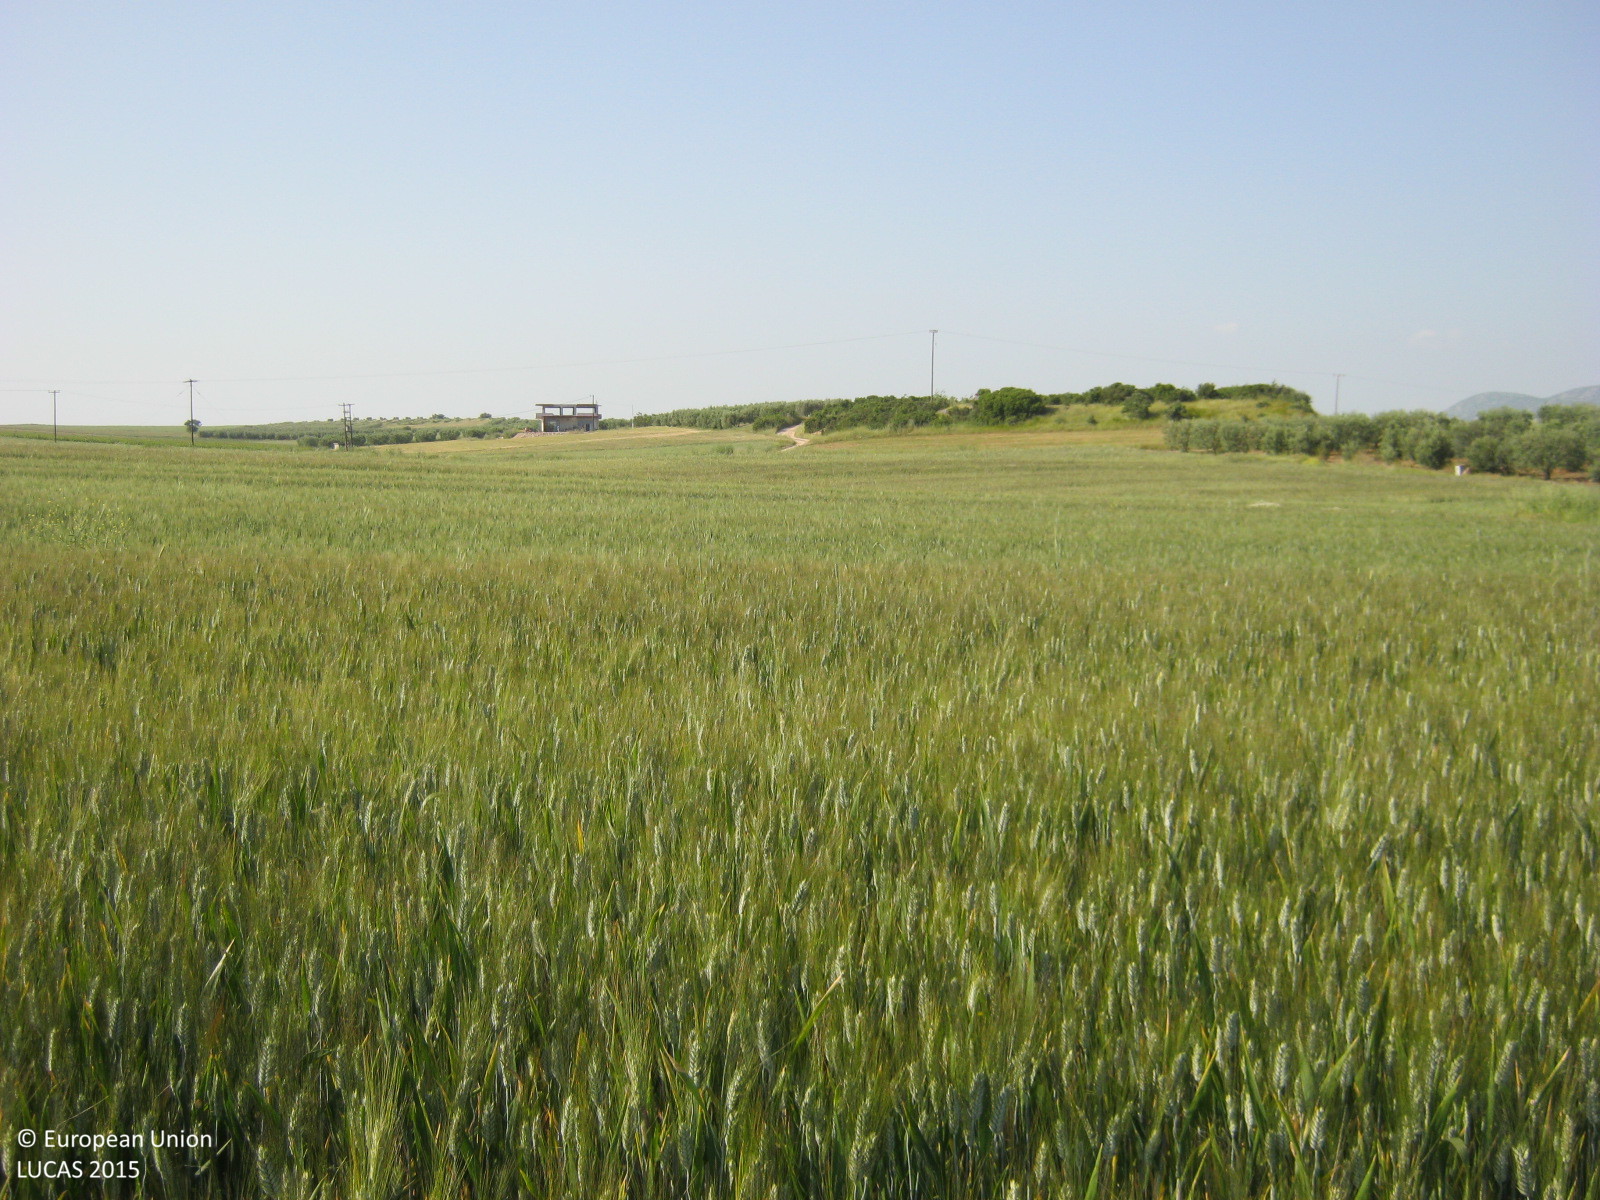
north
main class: Cropland
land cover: Common wheat
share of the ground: > 75 %
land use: Agriculture (excluding fallow land and kitchen gardens)
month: May
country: GR
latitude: 40.3324
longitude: 23.1299
